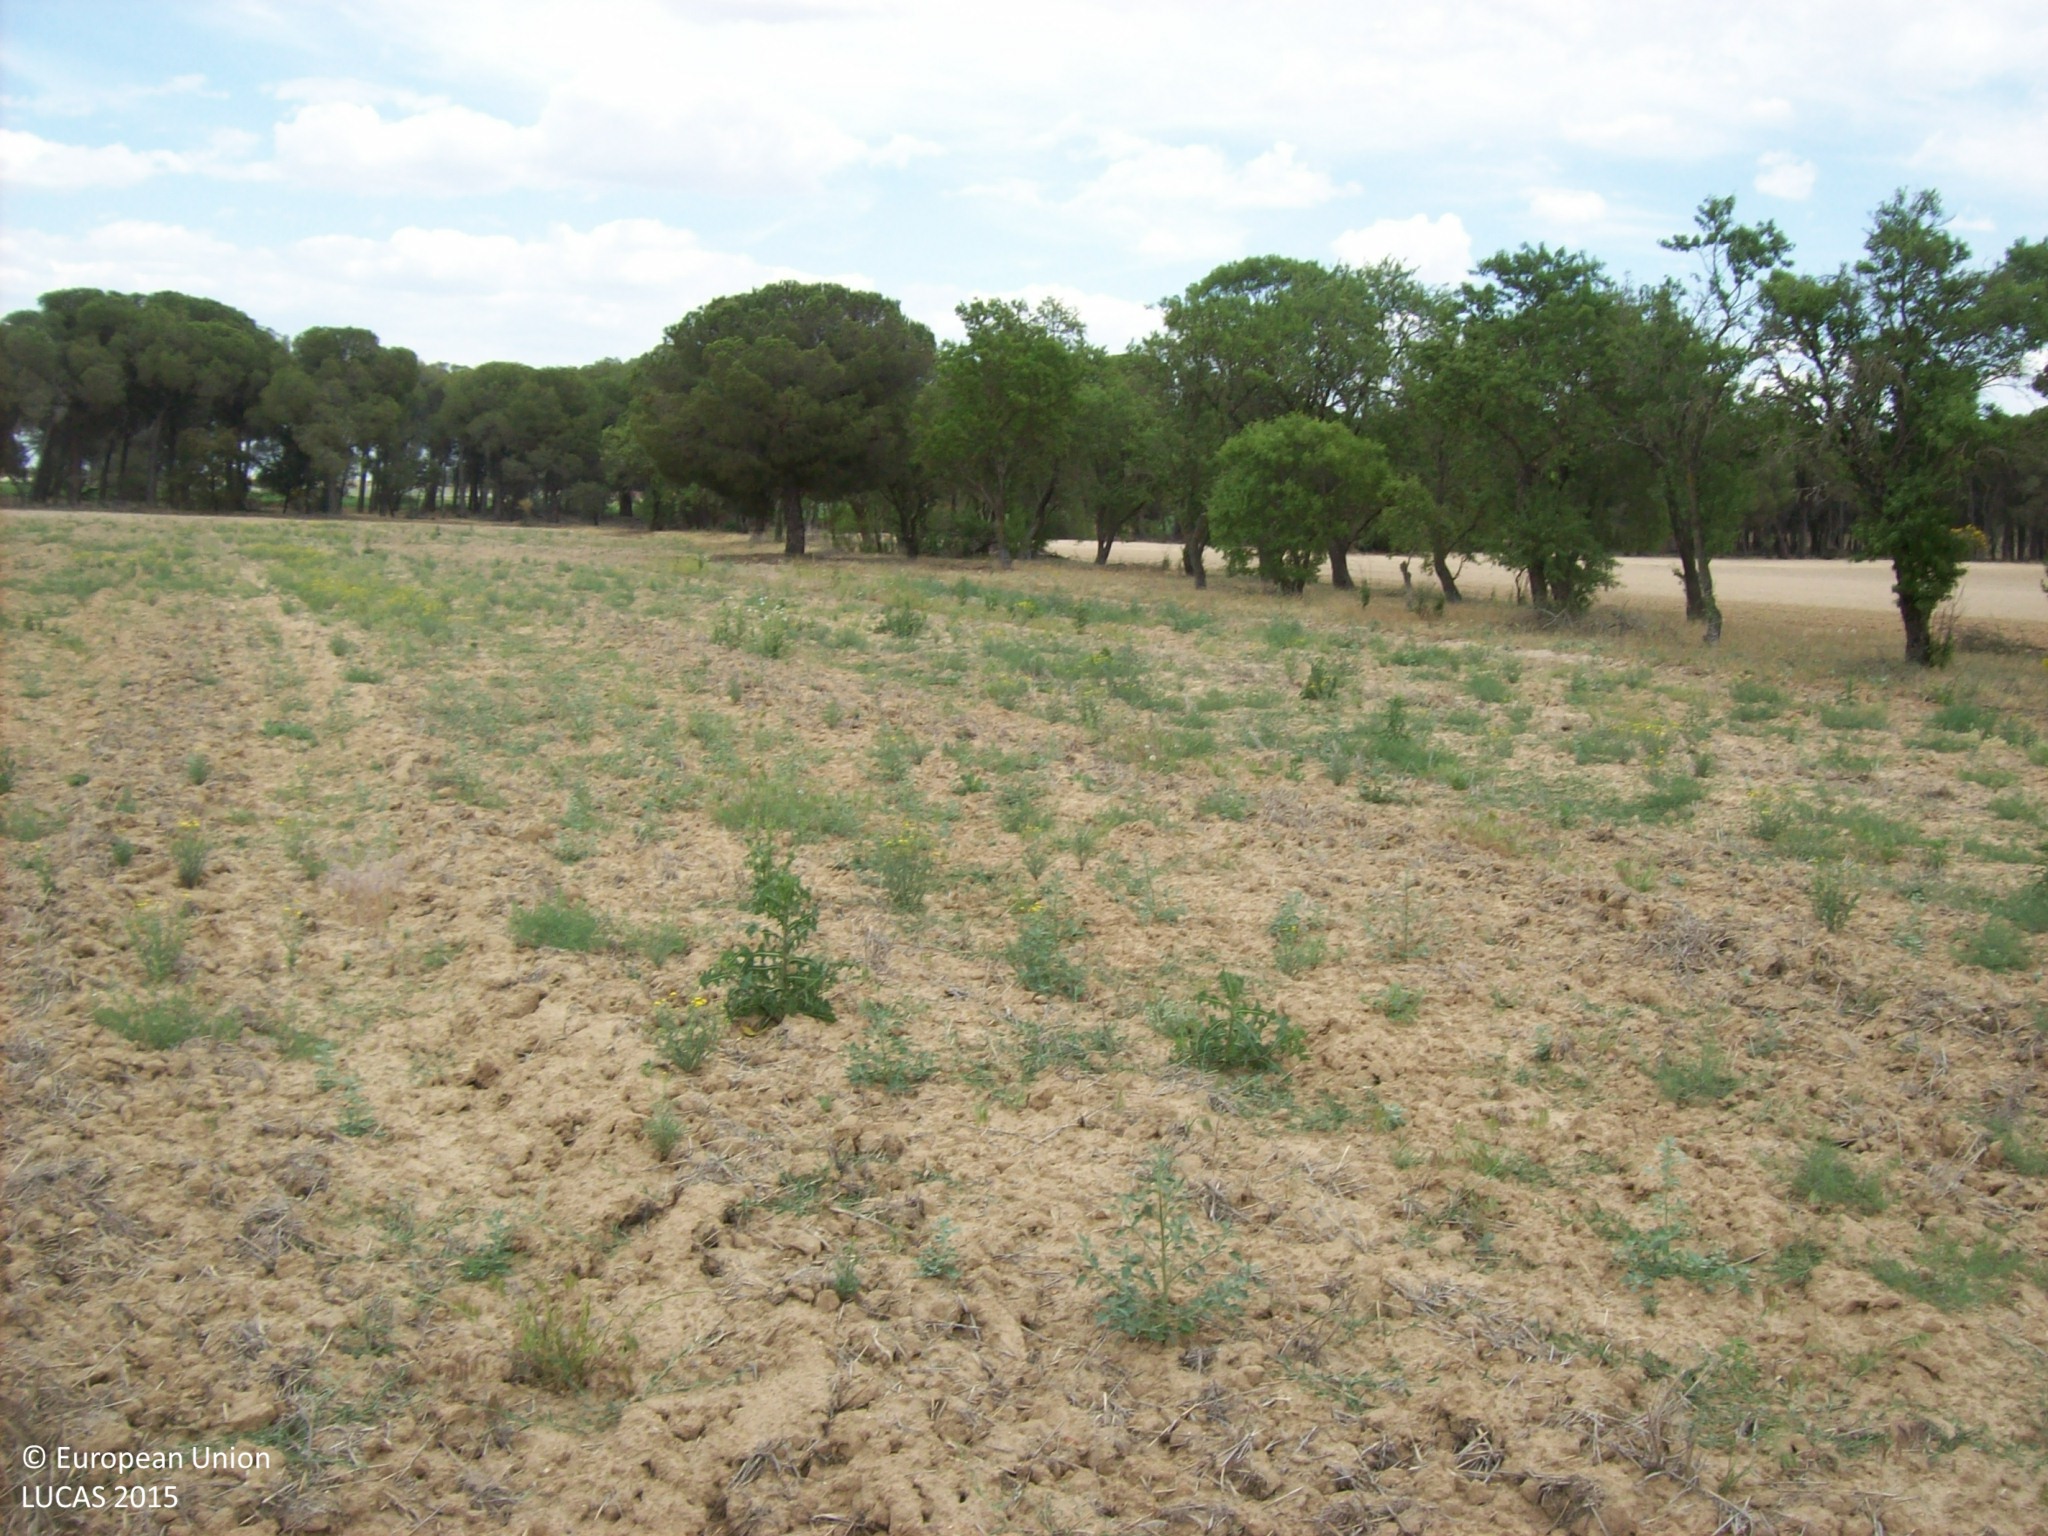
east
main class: Grassland
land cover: Spontaneously vegetated surfaces
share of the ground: 10 - 25 %
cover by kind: unconsolidated bare surface 85 %, herbaceous plants 15 %
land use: Fallow land
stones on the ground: < 10 %
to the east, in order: Spontaneously vegetated surfaces; Abandoned hedges; Tracks; Abandoned hedges; Other bare soil; Pine dominated coniferous woodland; Sugar beet
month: June
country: ES
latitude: 41.1769
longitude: -5.0284
